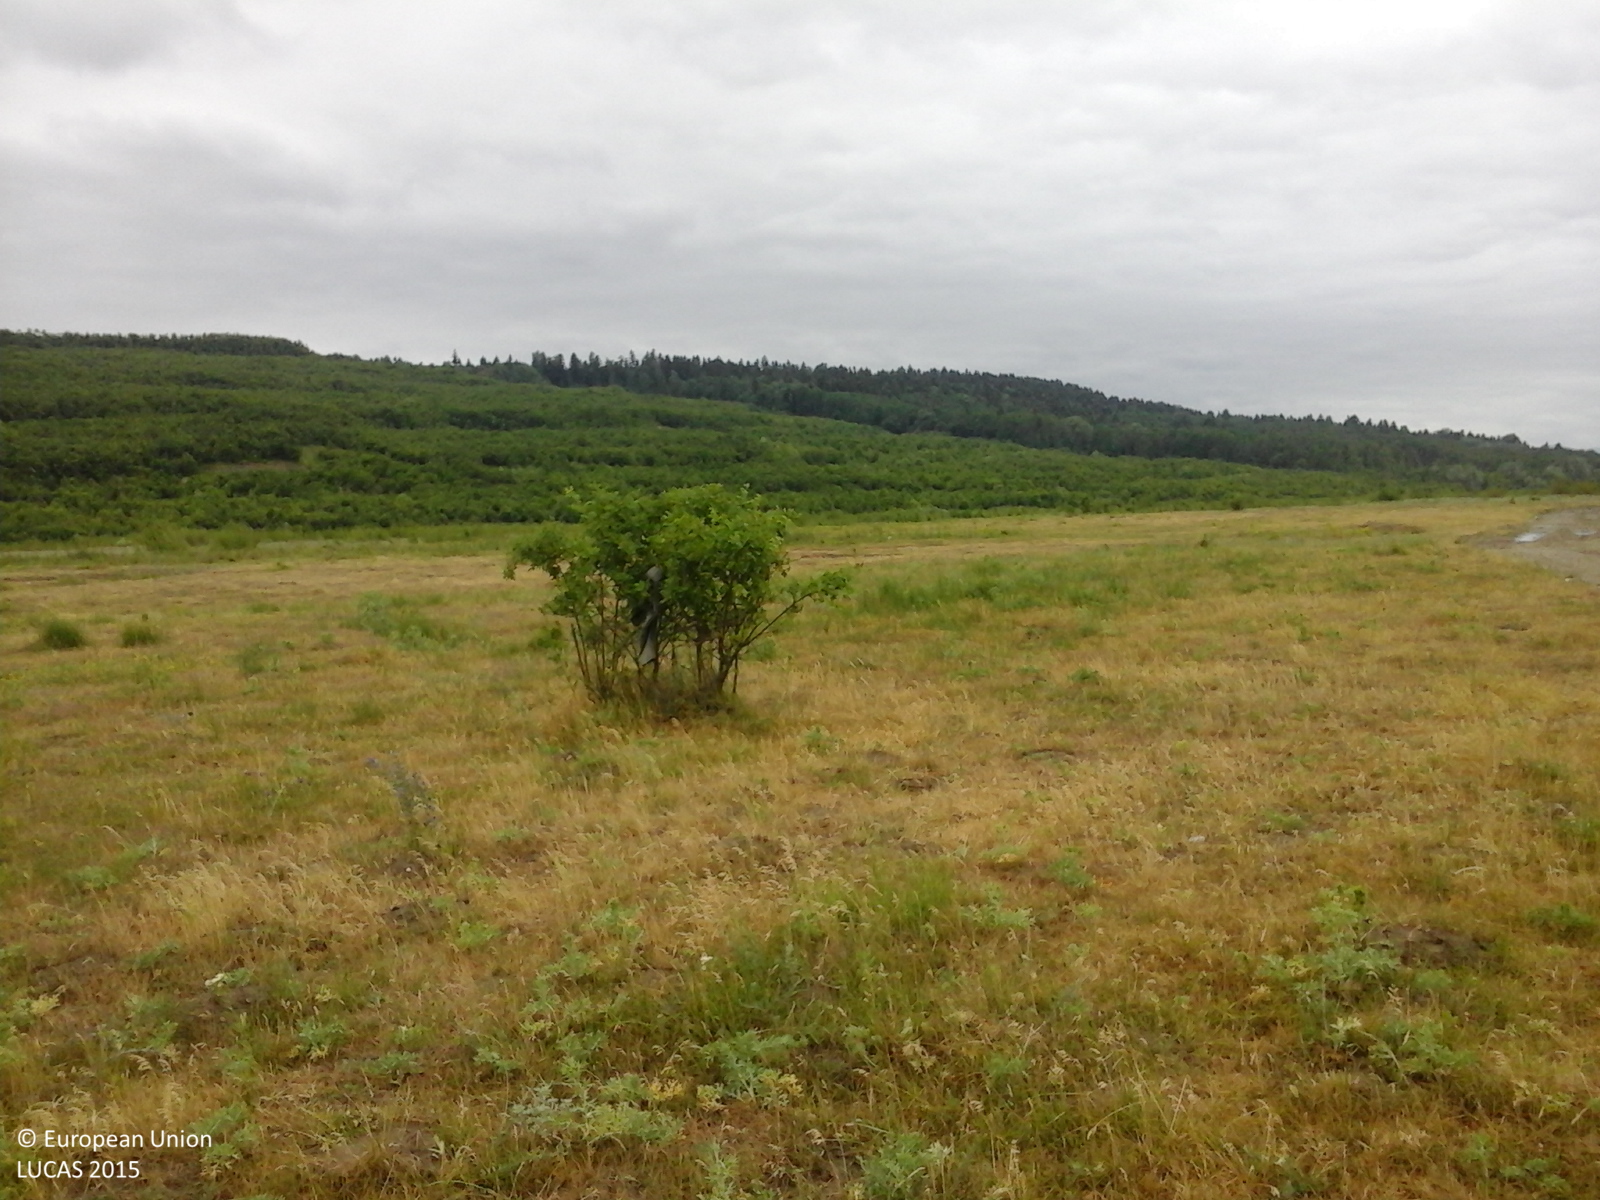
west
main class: Grassland
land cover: Grassland without tree/shrub cover
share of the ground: > 75 %
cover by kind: herbaceous plants 100 %
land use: Agriculture (excluding fallow land and kitchen gardens)
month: June
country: RO
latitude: 47.4207
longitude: 26.1851
